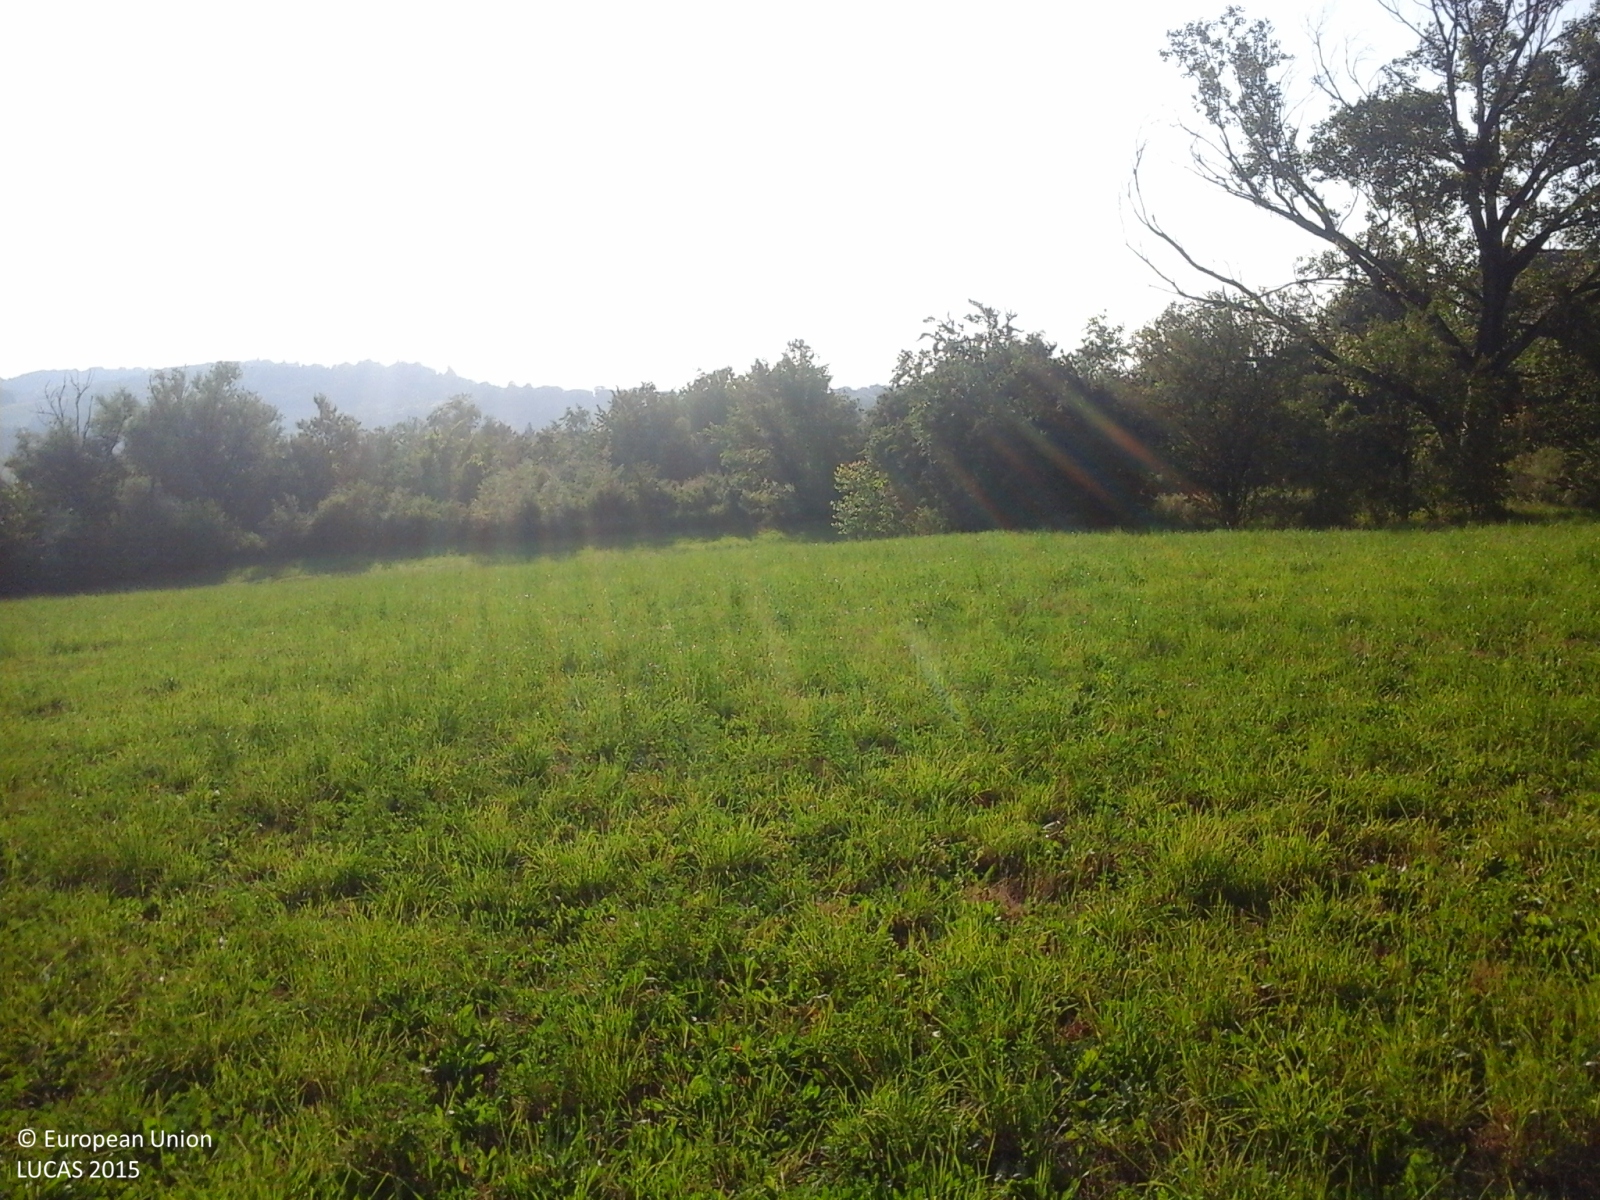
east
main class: Cropland
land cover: Lucerne
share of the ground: > 75 %
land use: Agriculture (excluding fallow land and kitchen gardens)
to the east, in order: Lucerne; Broadleaved woodland; Lucerne; Broadleaved woodland; Grassland without tree/shrub cover; Broadleaved woodland; Grassland without tree/shrub cover
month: June
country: IT
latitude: 44.8194
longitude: 9.9621
